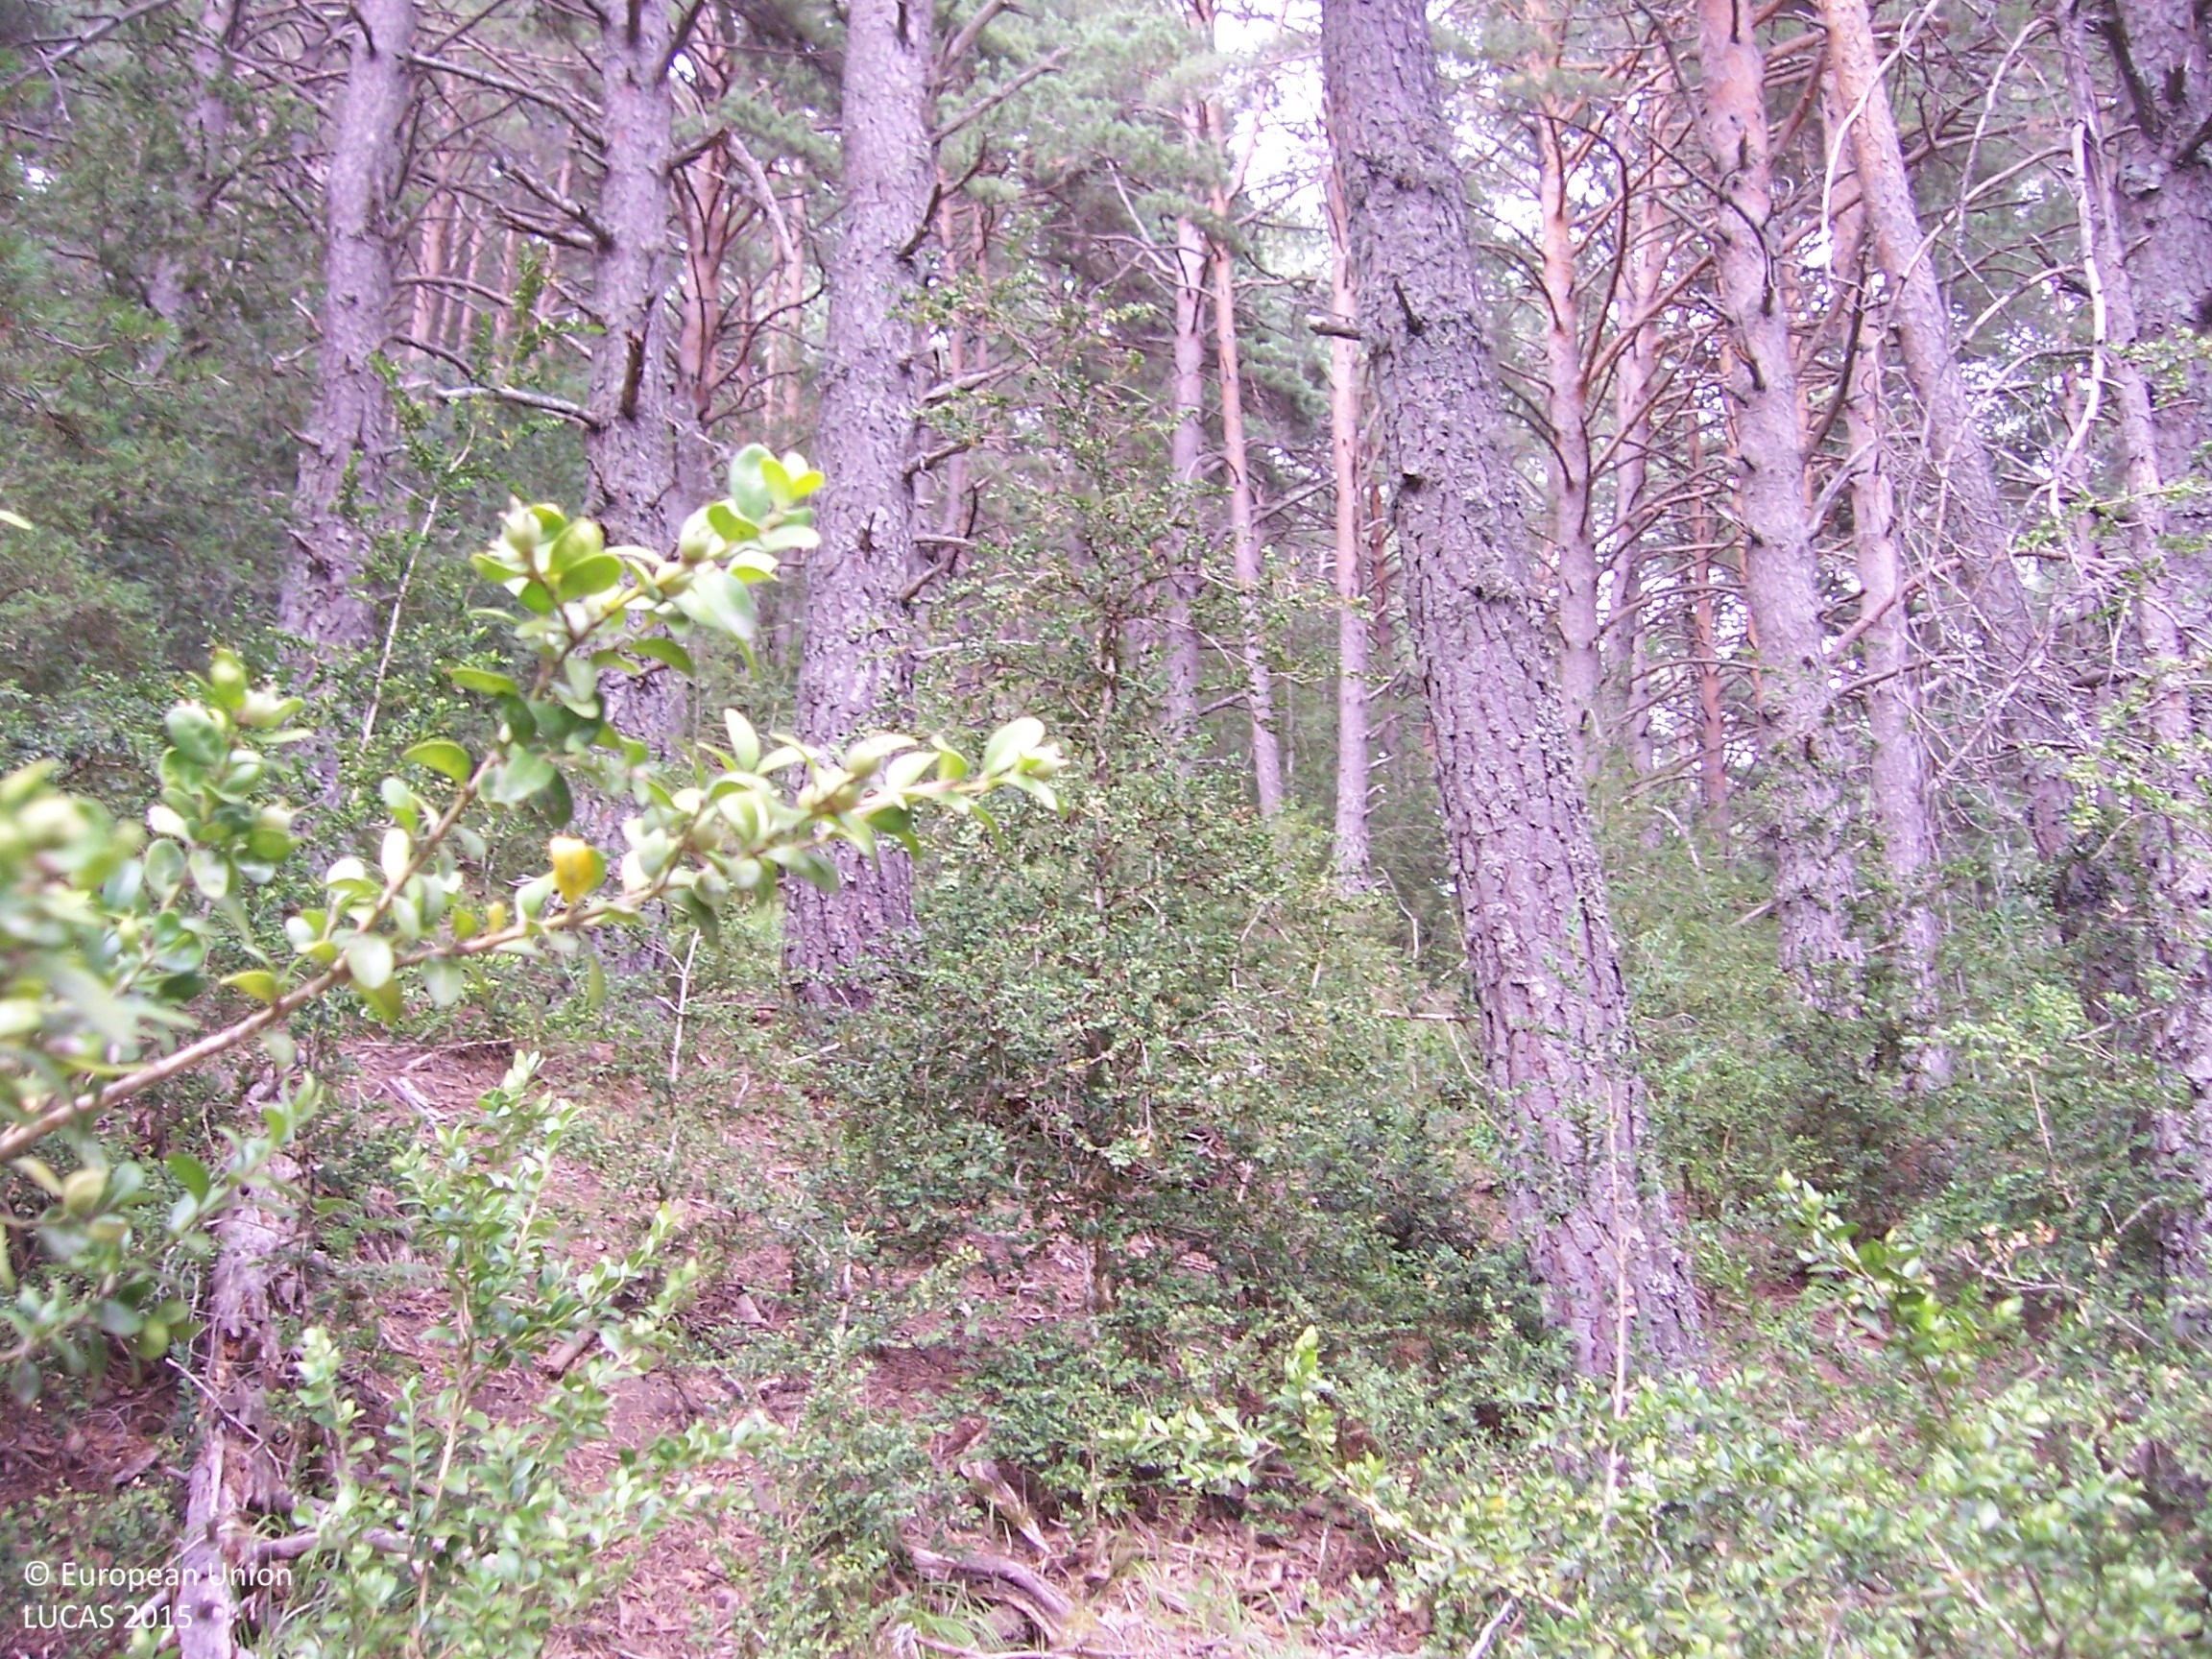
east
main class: Woodland
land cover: Pine dominated coniferous woodland
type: alpine coniferous forest
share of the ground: > 75 %
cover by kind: coniferous forest trees 80 %, shrubs 20 %
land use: Forestry
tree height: > 5 m
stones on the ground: < 10 %
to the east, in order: Pine dominated coniferous woodland
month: August
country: ES
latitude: 42.6878
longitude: -0.5120
